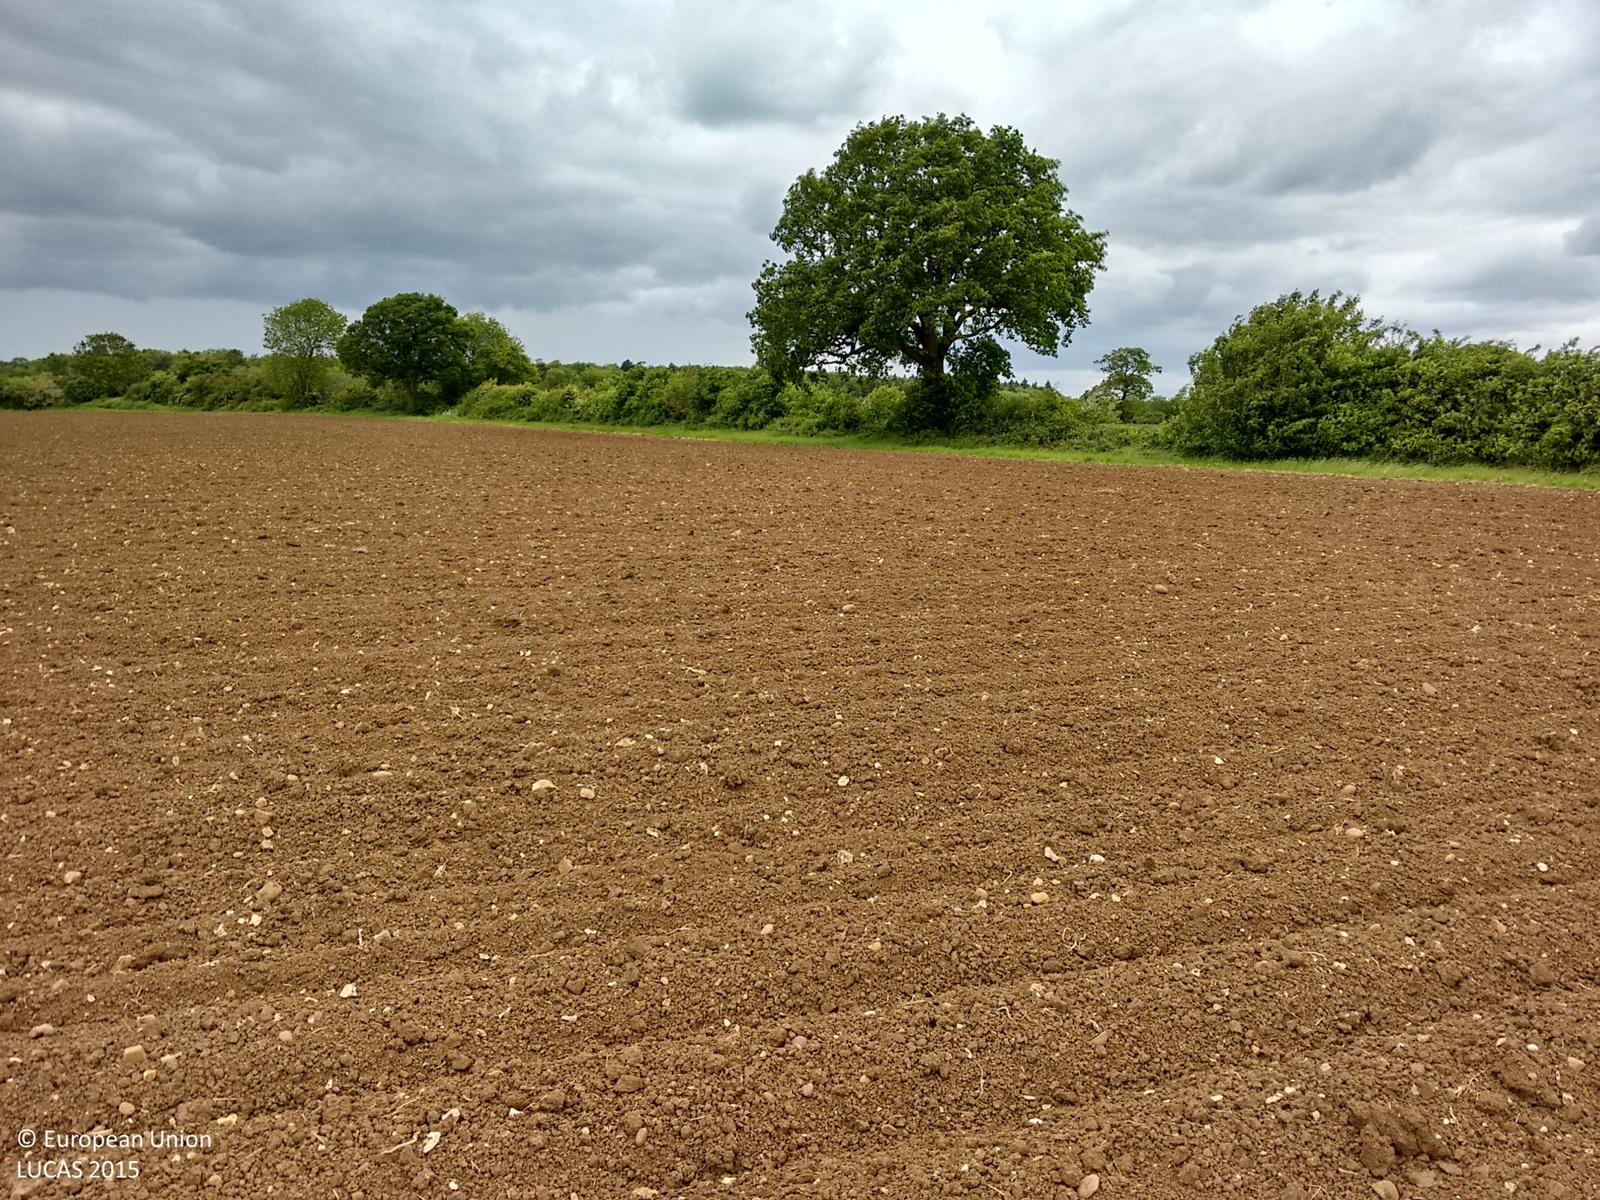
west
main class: Cropland
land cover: Dry pulses
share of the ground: < 10 %
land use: Agriculture (excluding fallow land and kitchen gardens)
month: June
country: GB
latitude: 52.2258
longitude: -0.6242
